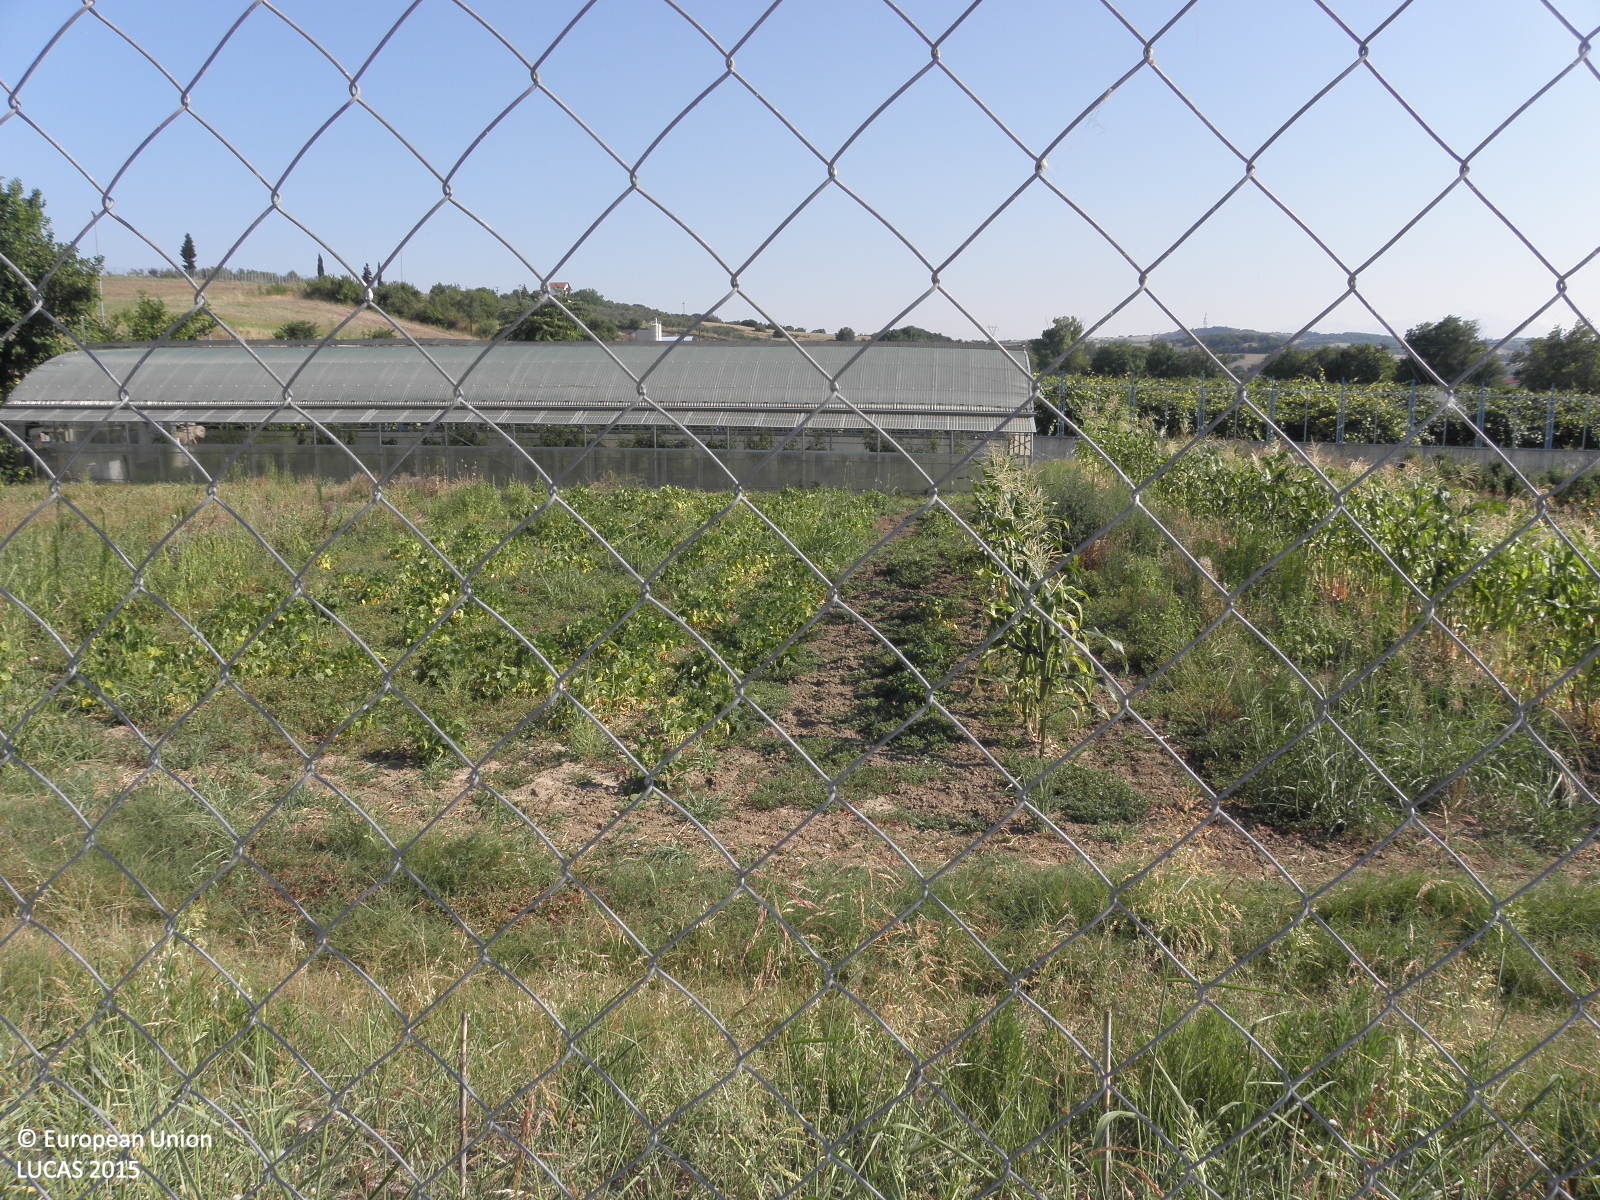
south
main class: Cropland
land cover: Other fresh vegetables
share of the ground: > 75 %
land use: Agriculture (excluding fallow land and kitchen gardens)
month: July
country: GR
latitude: 40.4800
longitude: 22.5642
